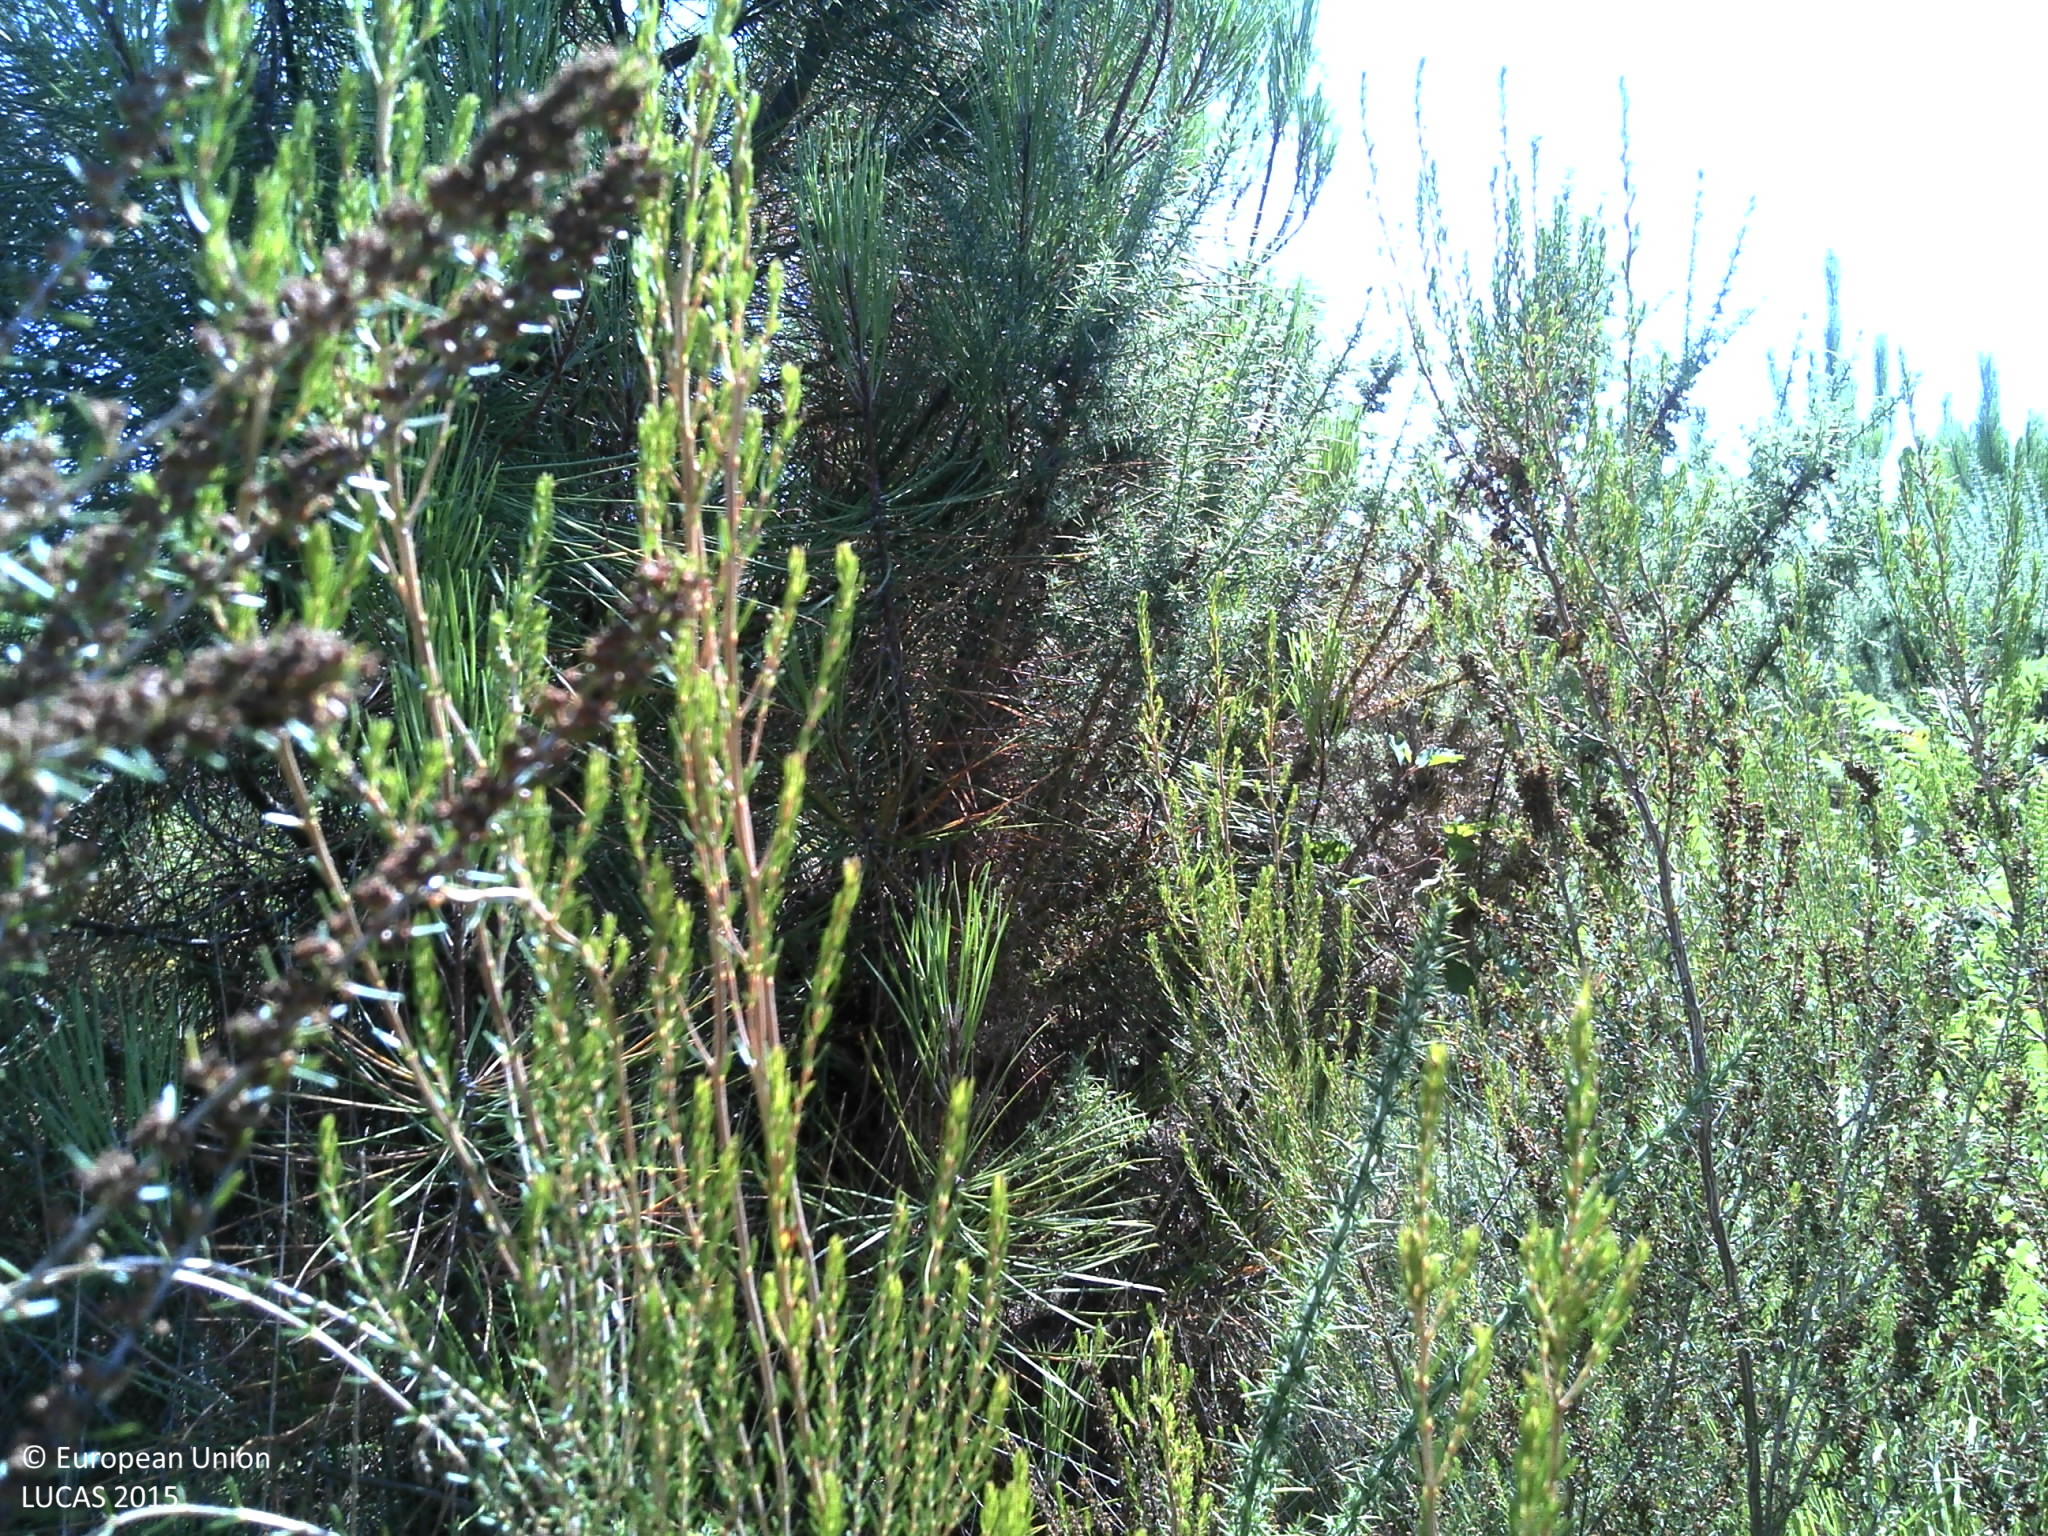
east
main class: Woodland
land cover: Pine dominated coniferous woodland
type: coniferous forest of the mediterranean region
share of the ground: > 75 %
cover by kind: coniferous forest trees 60 %, shrubs 30 %, herbaceous plants 5 %, lichens and mosses 5 %
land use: Forestry
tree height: > 5 m
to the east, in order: Pine dominated coniferous woodland
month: August
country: FR
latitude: 45.0311
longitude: -1.0544
